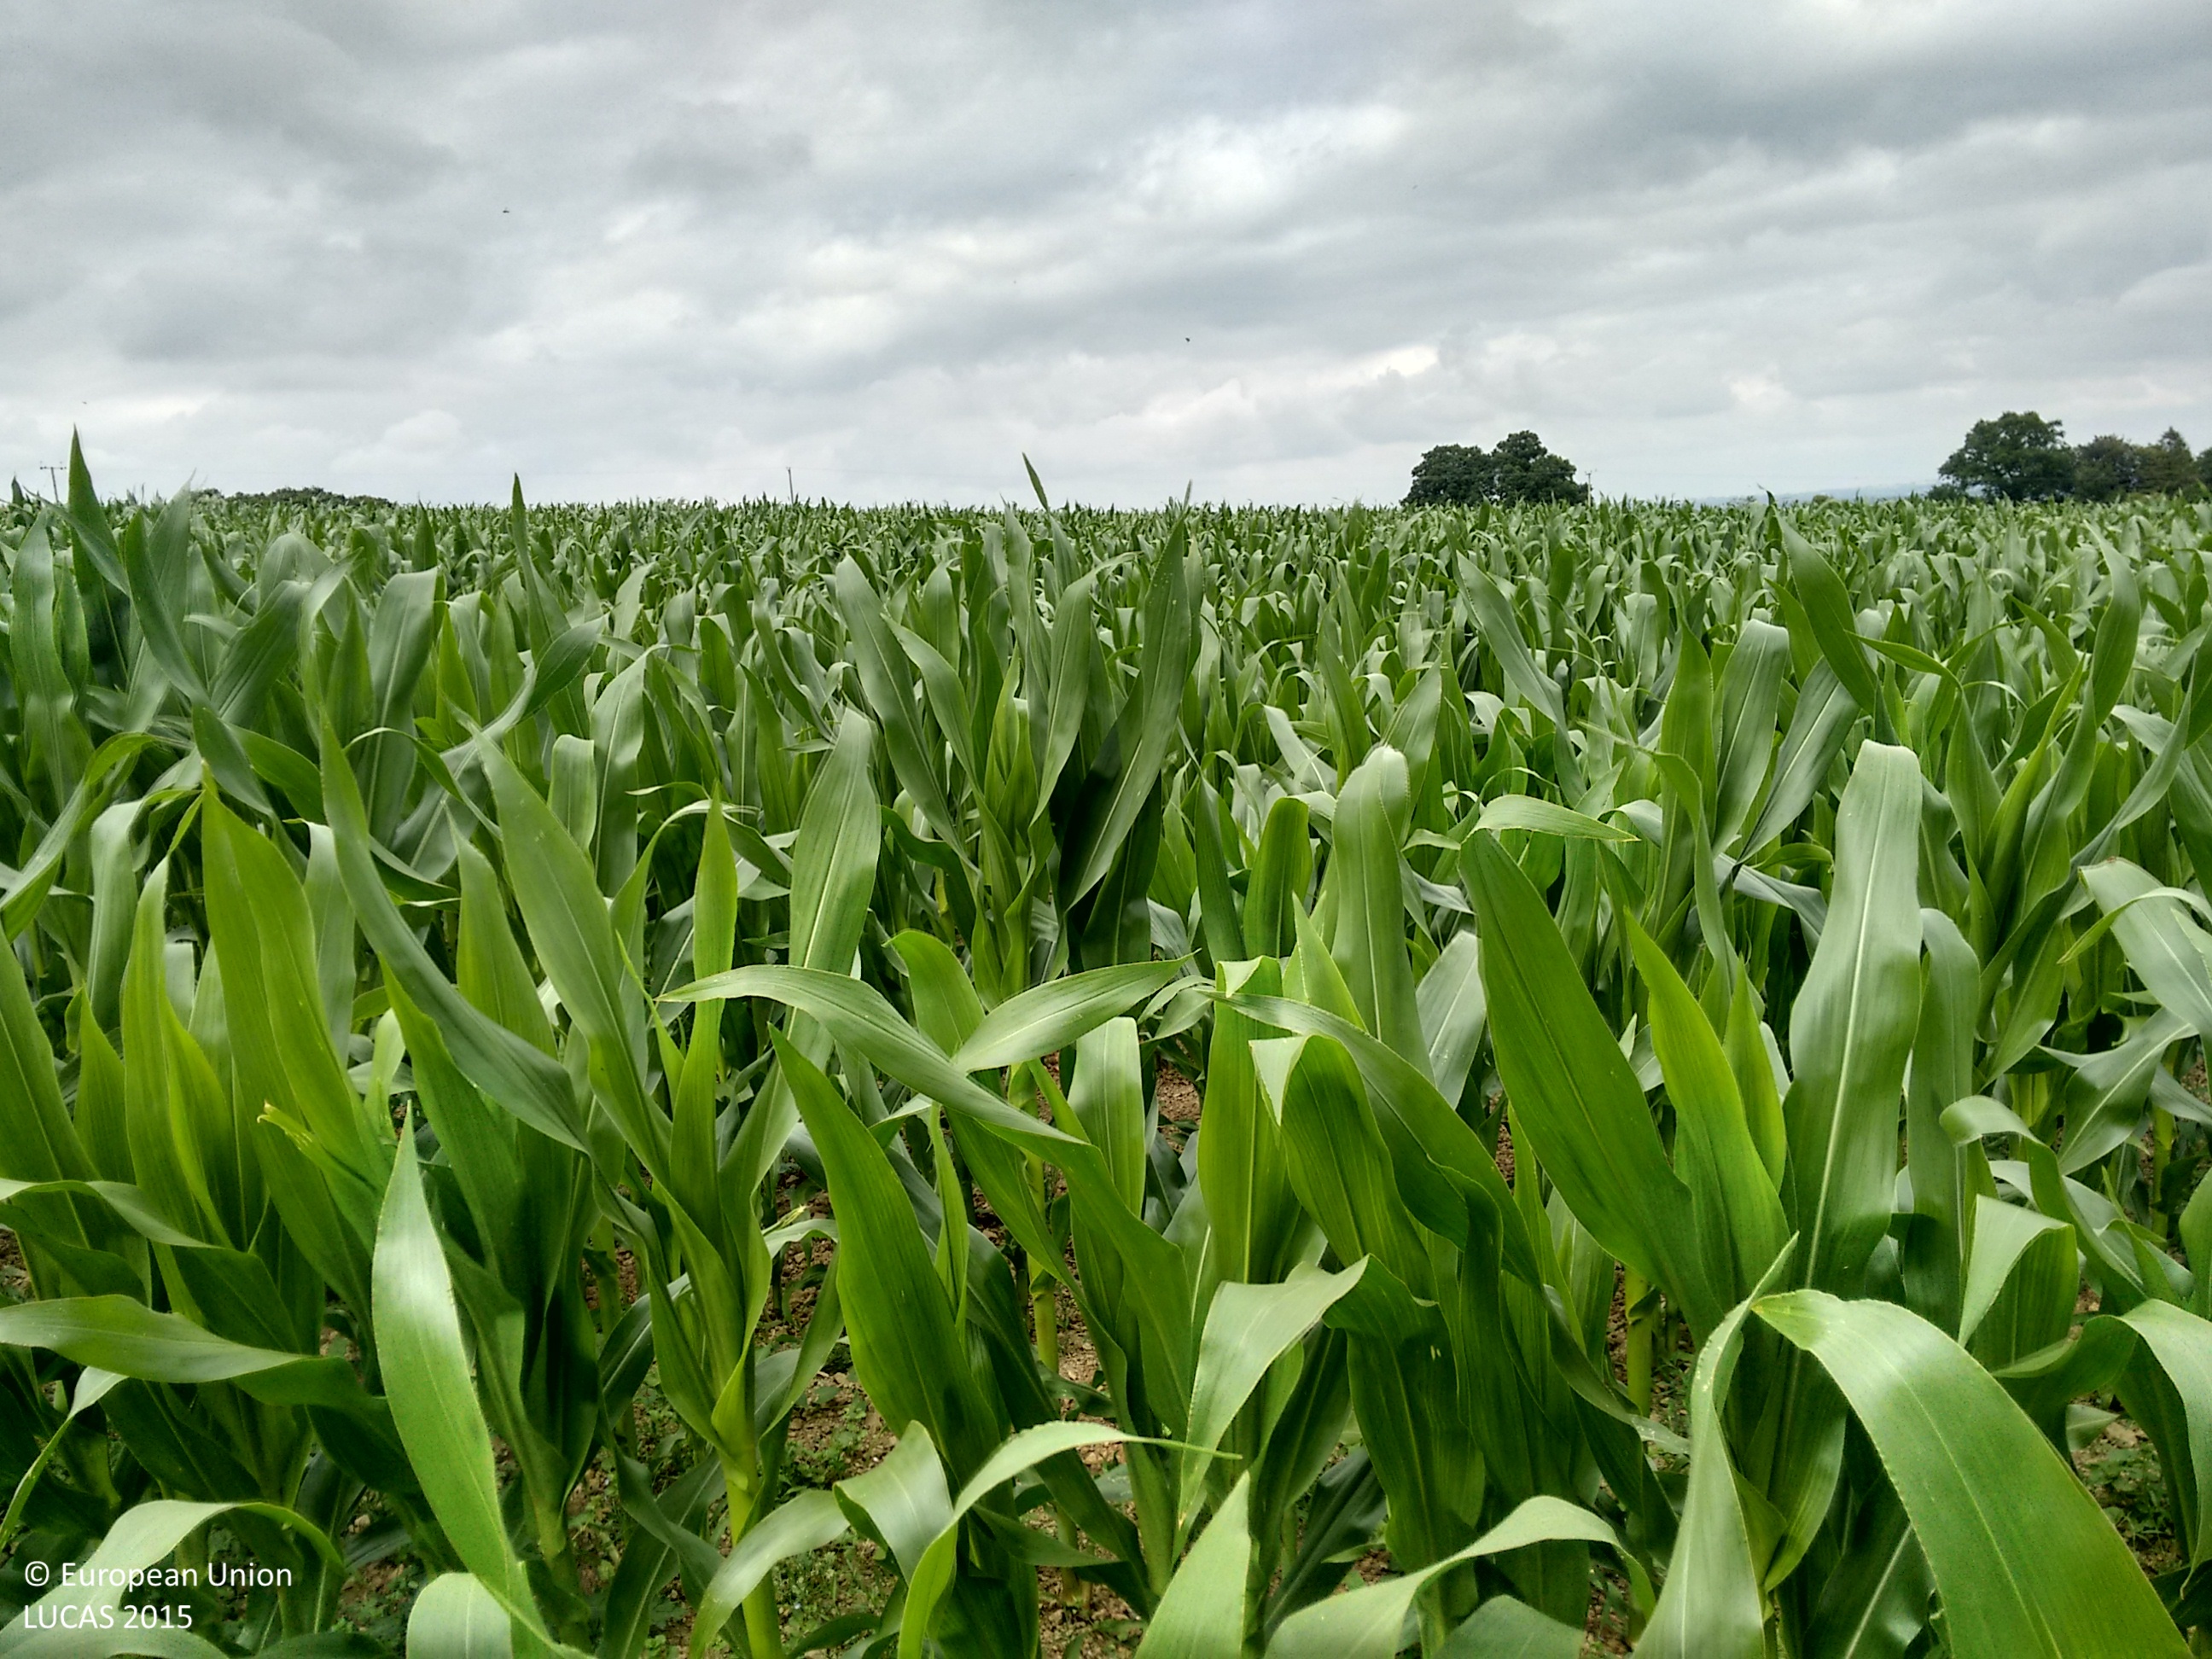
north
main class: Cropland
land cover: Maize
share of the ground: > 75 %
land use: Agriculture (excluding fallow land and kitchen gardens)
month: July
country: GB
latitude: 51.9848
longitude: -2.5163
